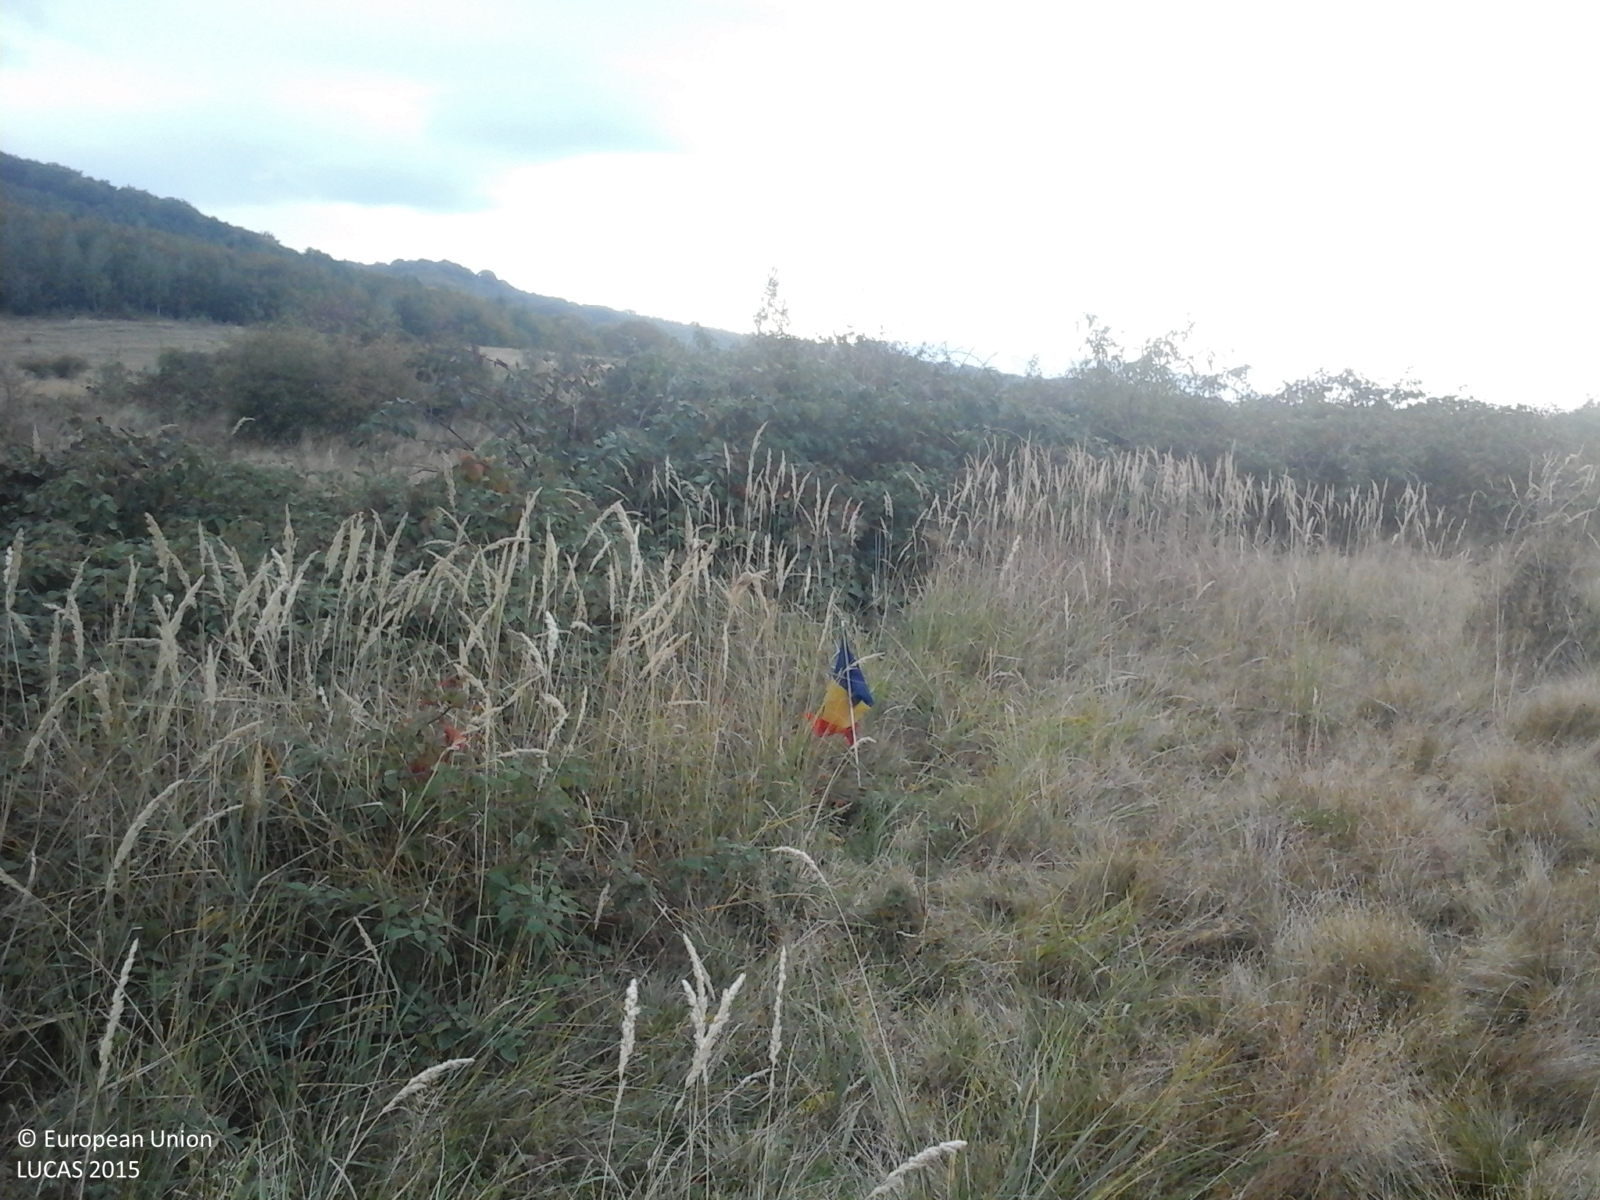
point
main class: Shrubland
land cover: Shrubland without tree cover
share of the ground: > 75 %
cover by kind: shrubs 100 %
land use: Semi-natural and natural areas not in use
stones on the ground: < 10 %
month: October
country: RO
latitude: 45.7096
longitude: 25.1101
